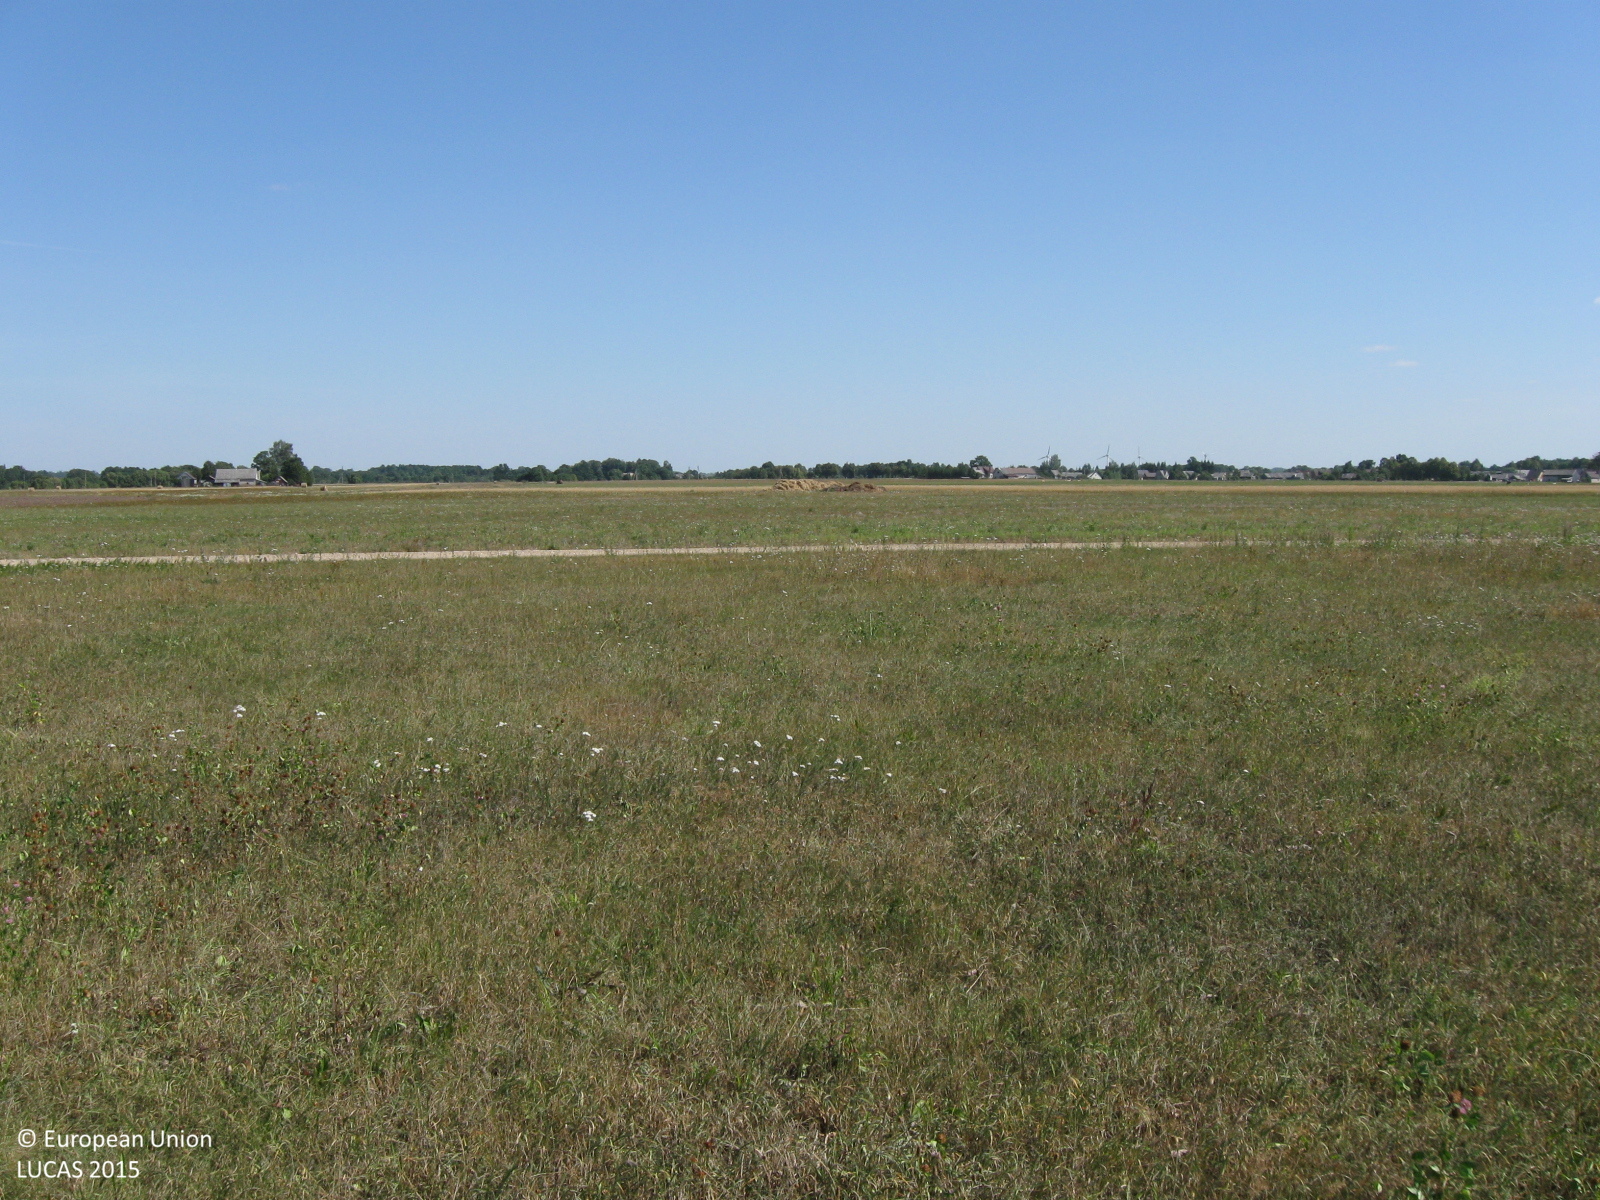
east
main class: Grassland
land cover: Grassland without tree/shrub cover
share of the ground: > 75 %
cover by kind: herbaceous plants 100 %
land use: Agriculture (excluding fallow land and kitchen gardens)
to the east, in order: Grassland without tree/shrub cover; Paved roads, cycling and walking lanes; Grassland without tree/shrub cover
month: August
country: LT
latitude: 55.3367
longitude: 22.5005
